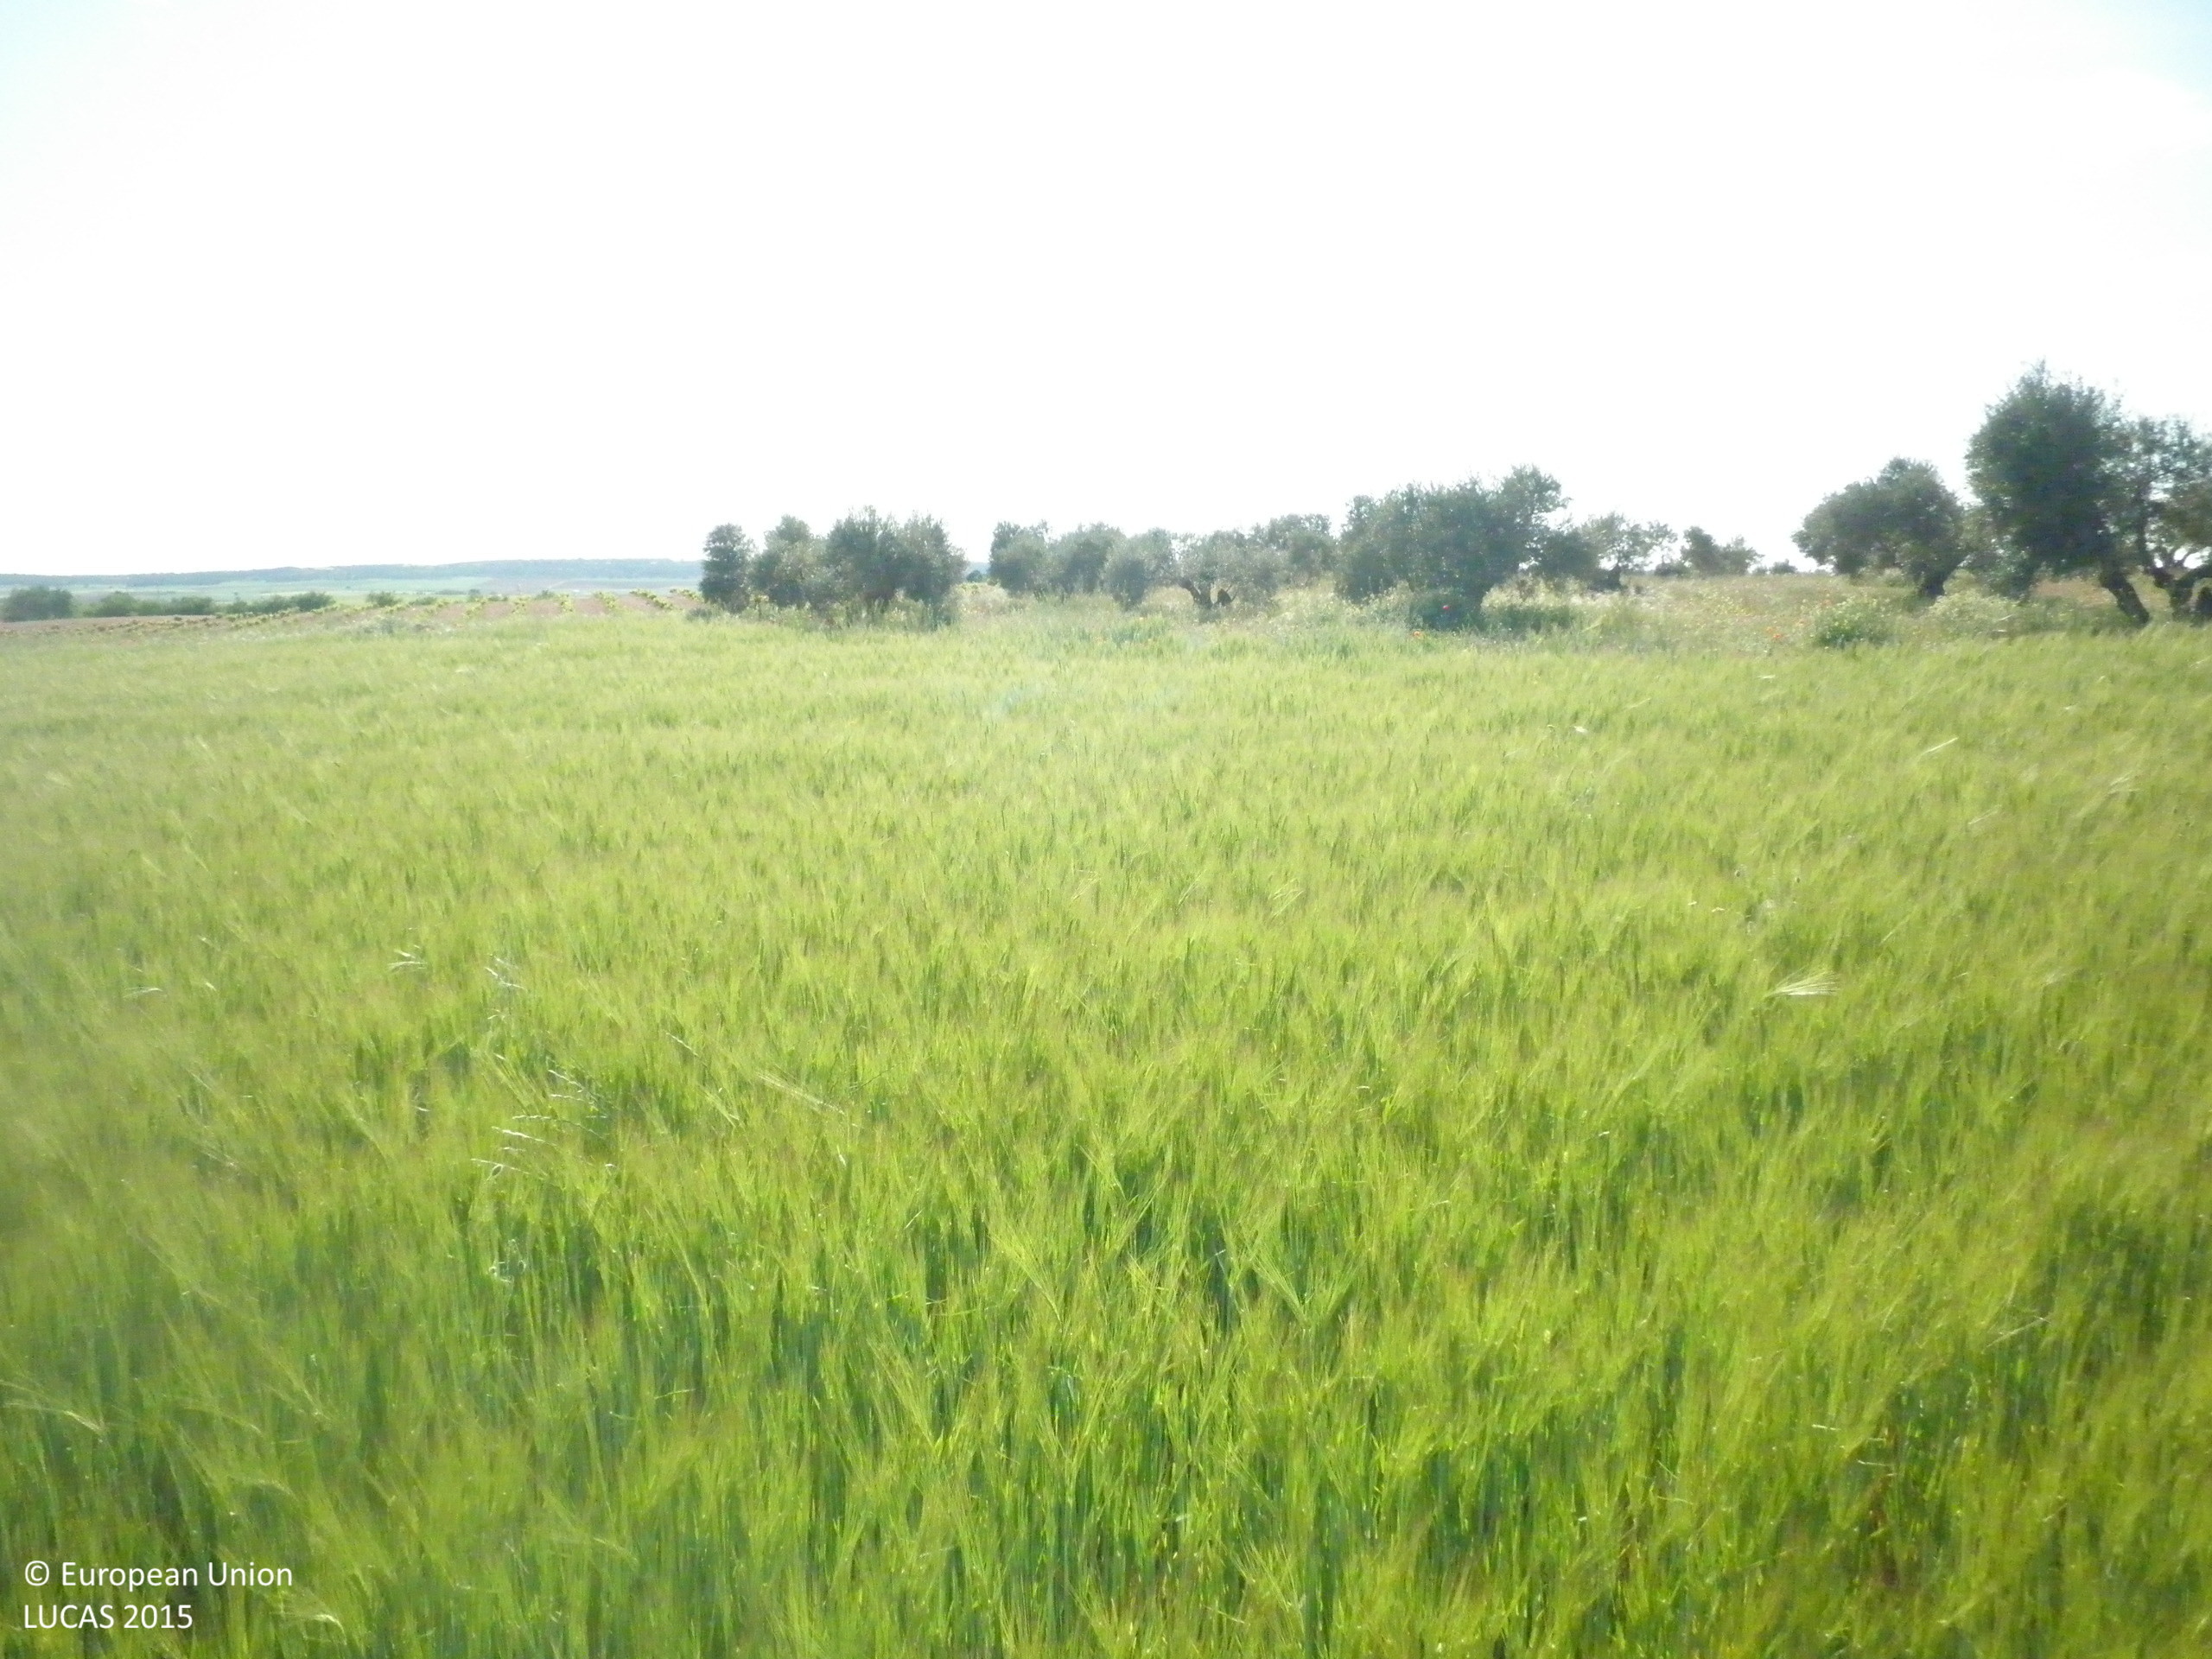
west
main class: Cropland
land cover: Barley
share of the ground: > 75 %
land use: Agriculture (excluding fallow land and kitchen gardens)
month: May
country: ES
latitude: 39.6716
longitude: -2.7351
